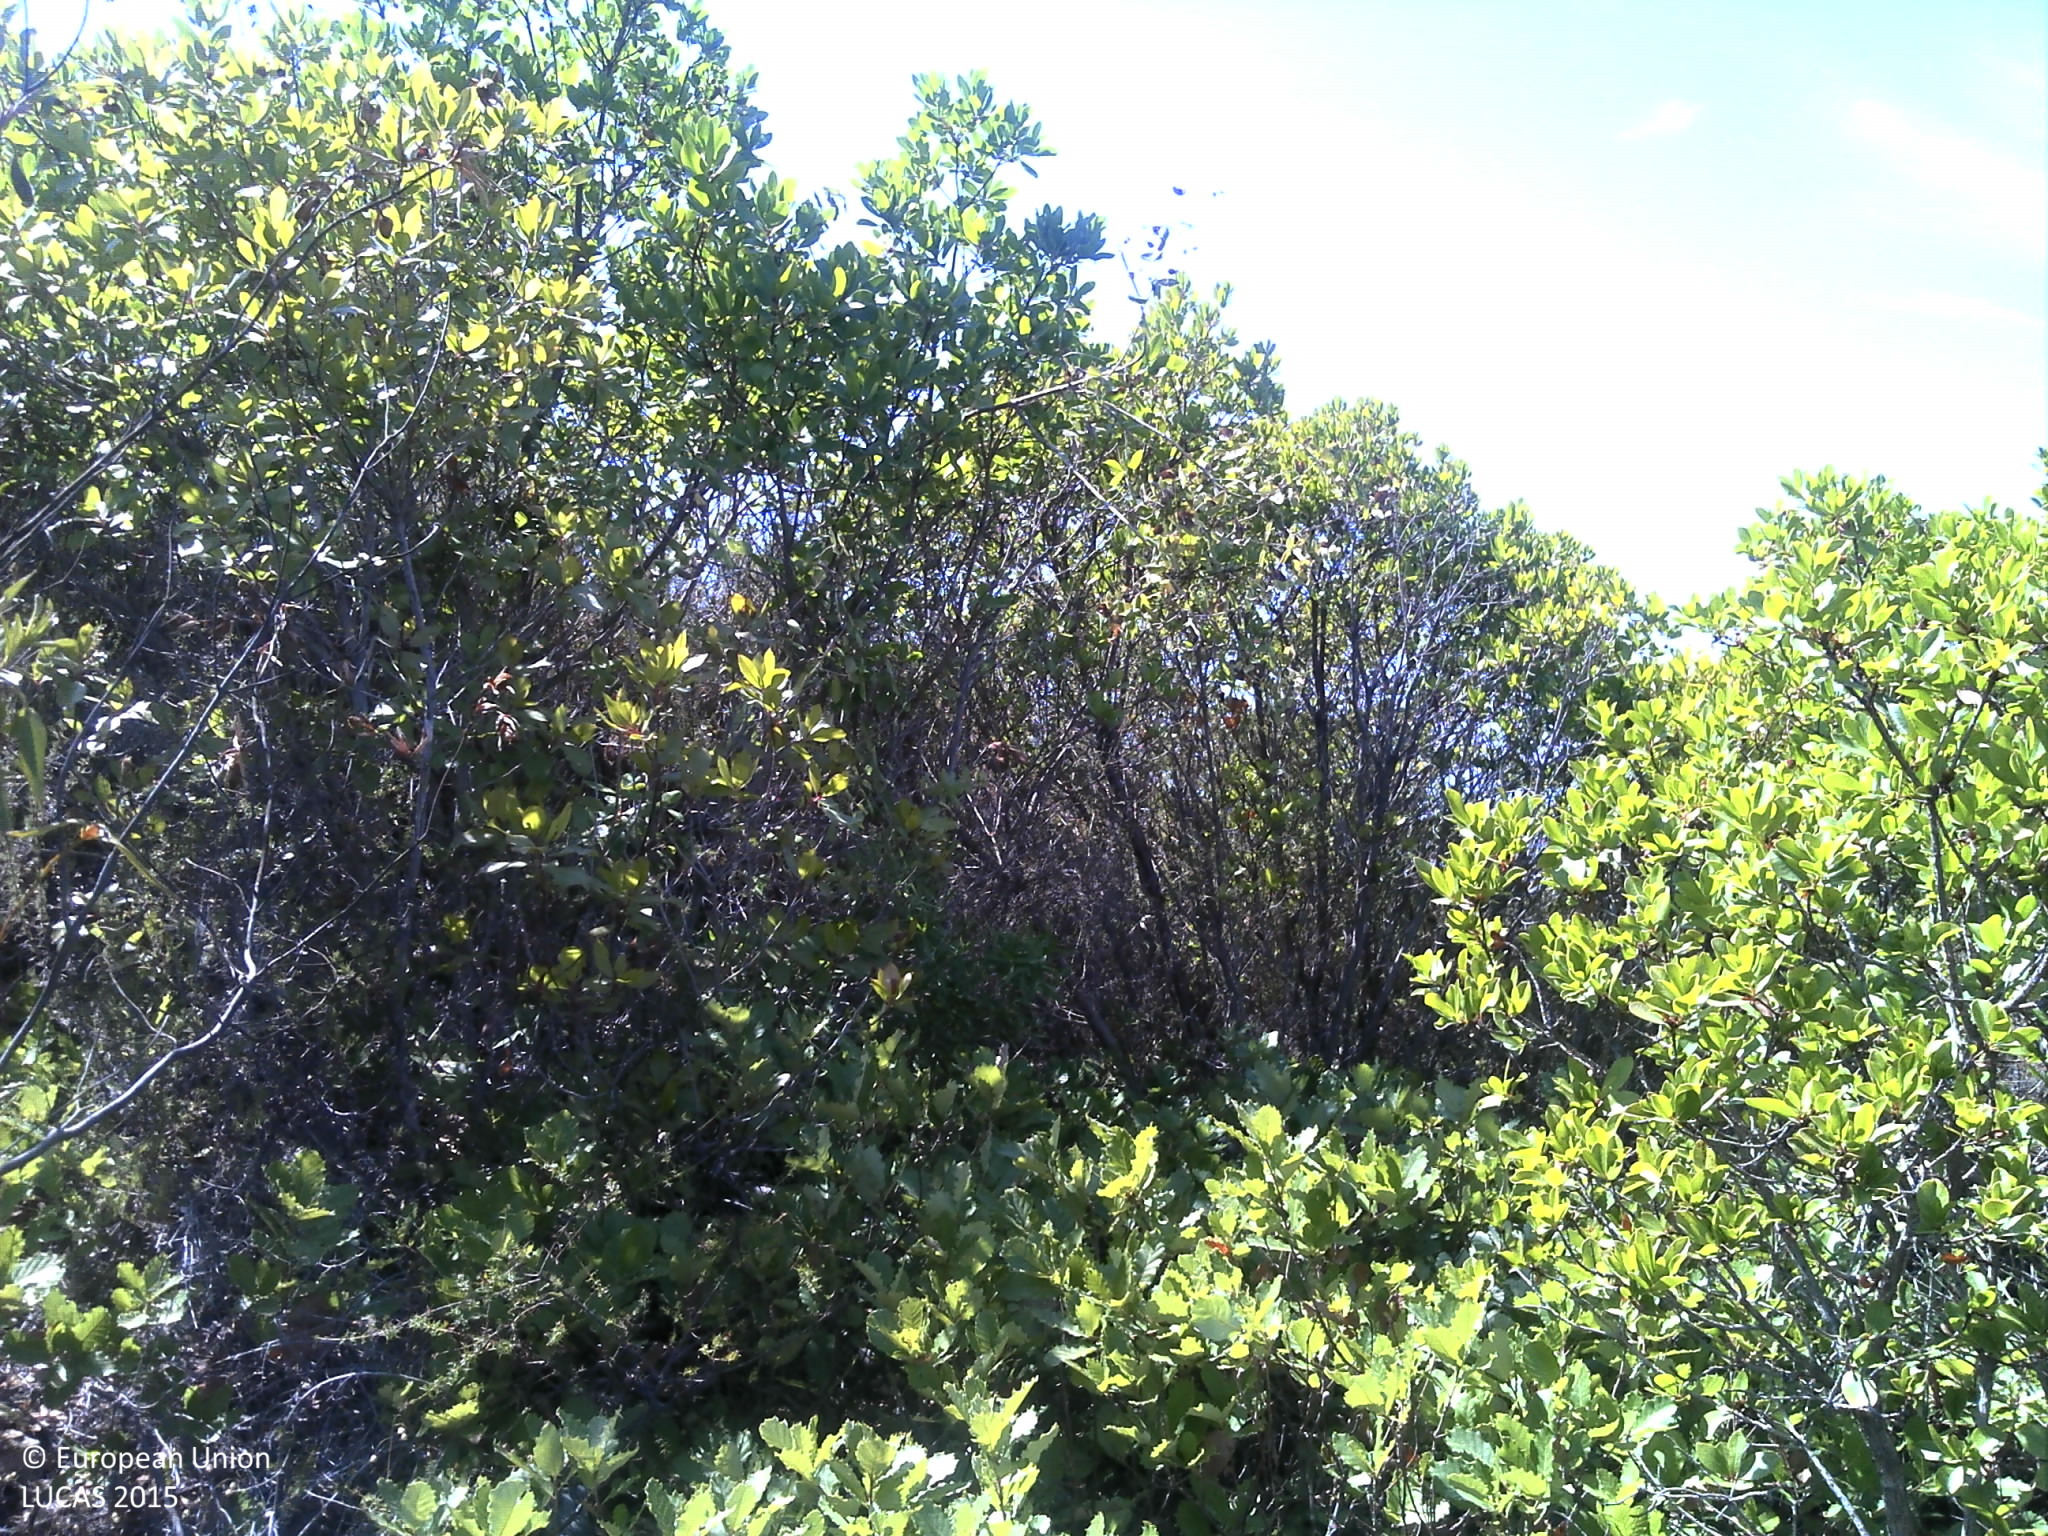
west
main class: Shrubland
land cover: Shrubland with sparse tree cover
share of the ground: 50 - 75 %
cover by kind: shrubs 70 %, unconsolidated bare surface 25 %, broadleaved forest trees 5 %
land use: Abandoned areas
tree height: < 5 m
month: September
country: PT
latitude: 37.4016
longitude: -8.1994
